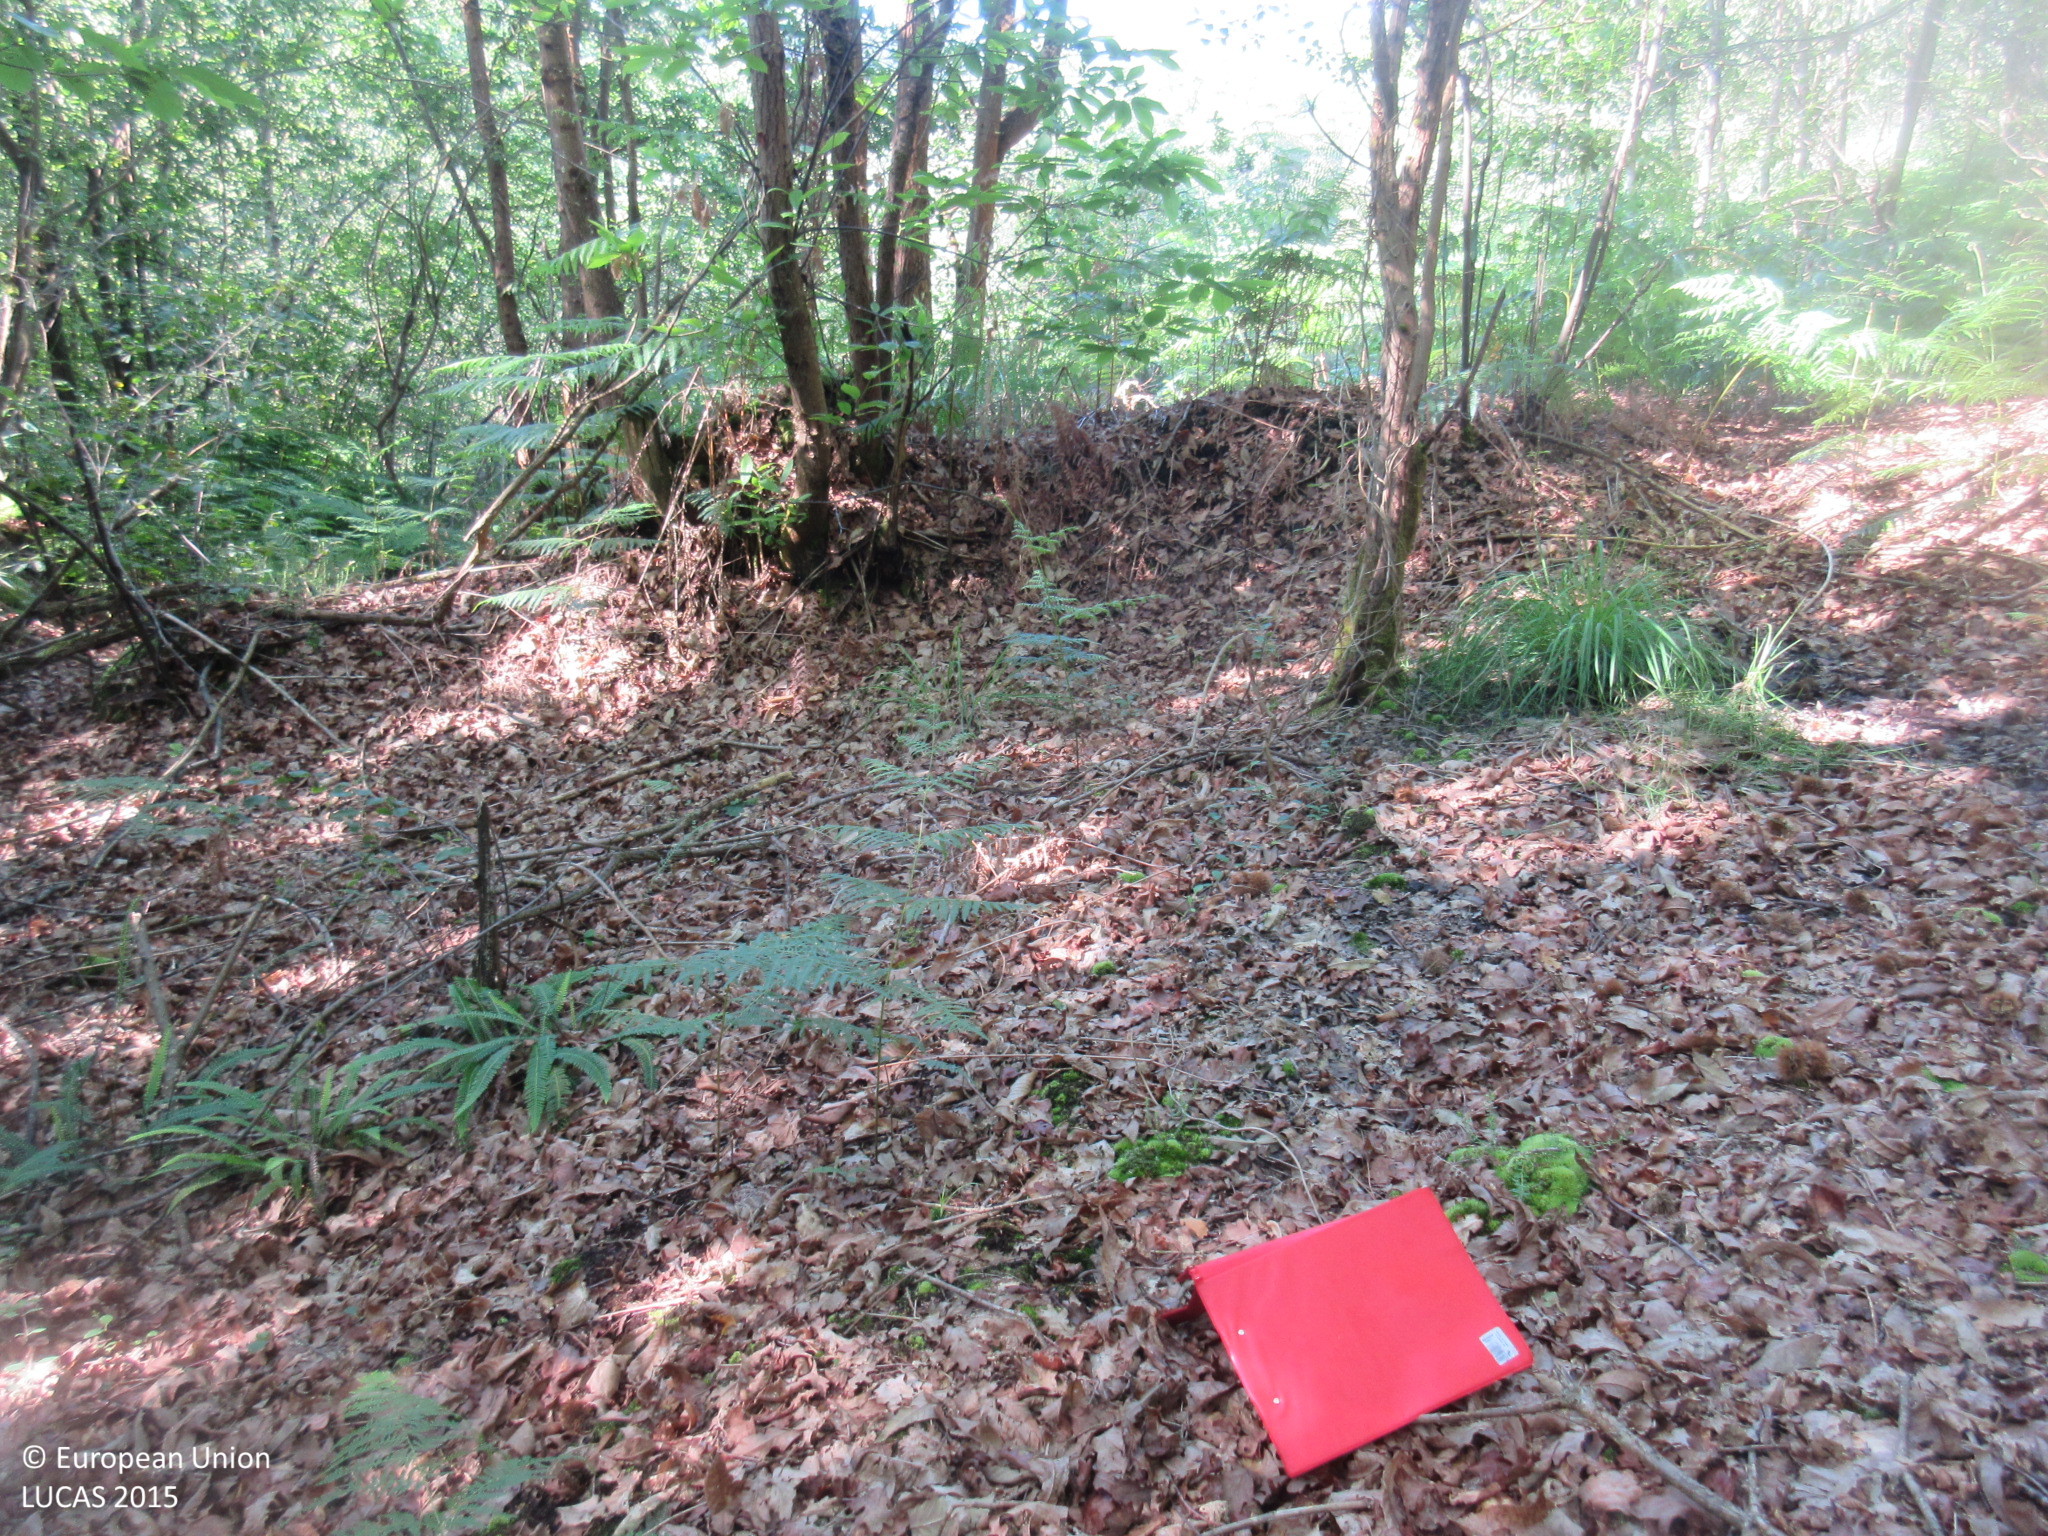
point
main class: Woodland
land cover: Broadleaved woodland
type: thermophilous deciduous forest
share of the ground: > 75 %
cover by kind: broadleaved forest trees 100 %
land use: Forestry
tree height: > 5 m
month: June
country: ES
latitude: 43.3885
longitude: -6.0292
